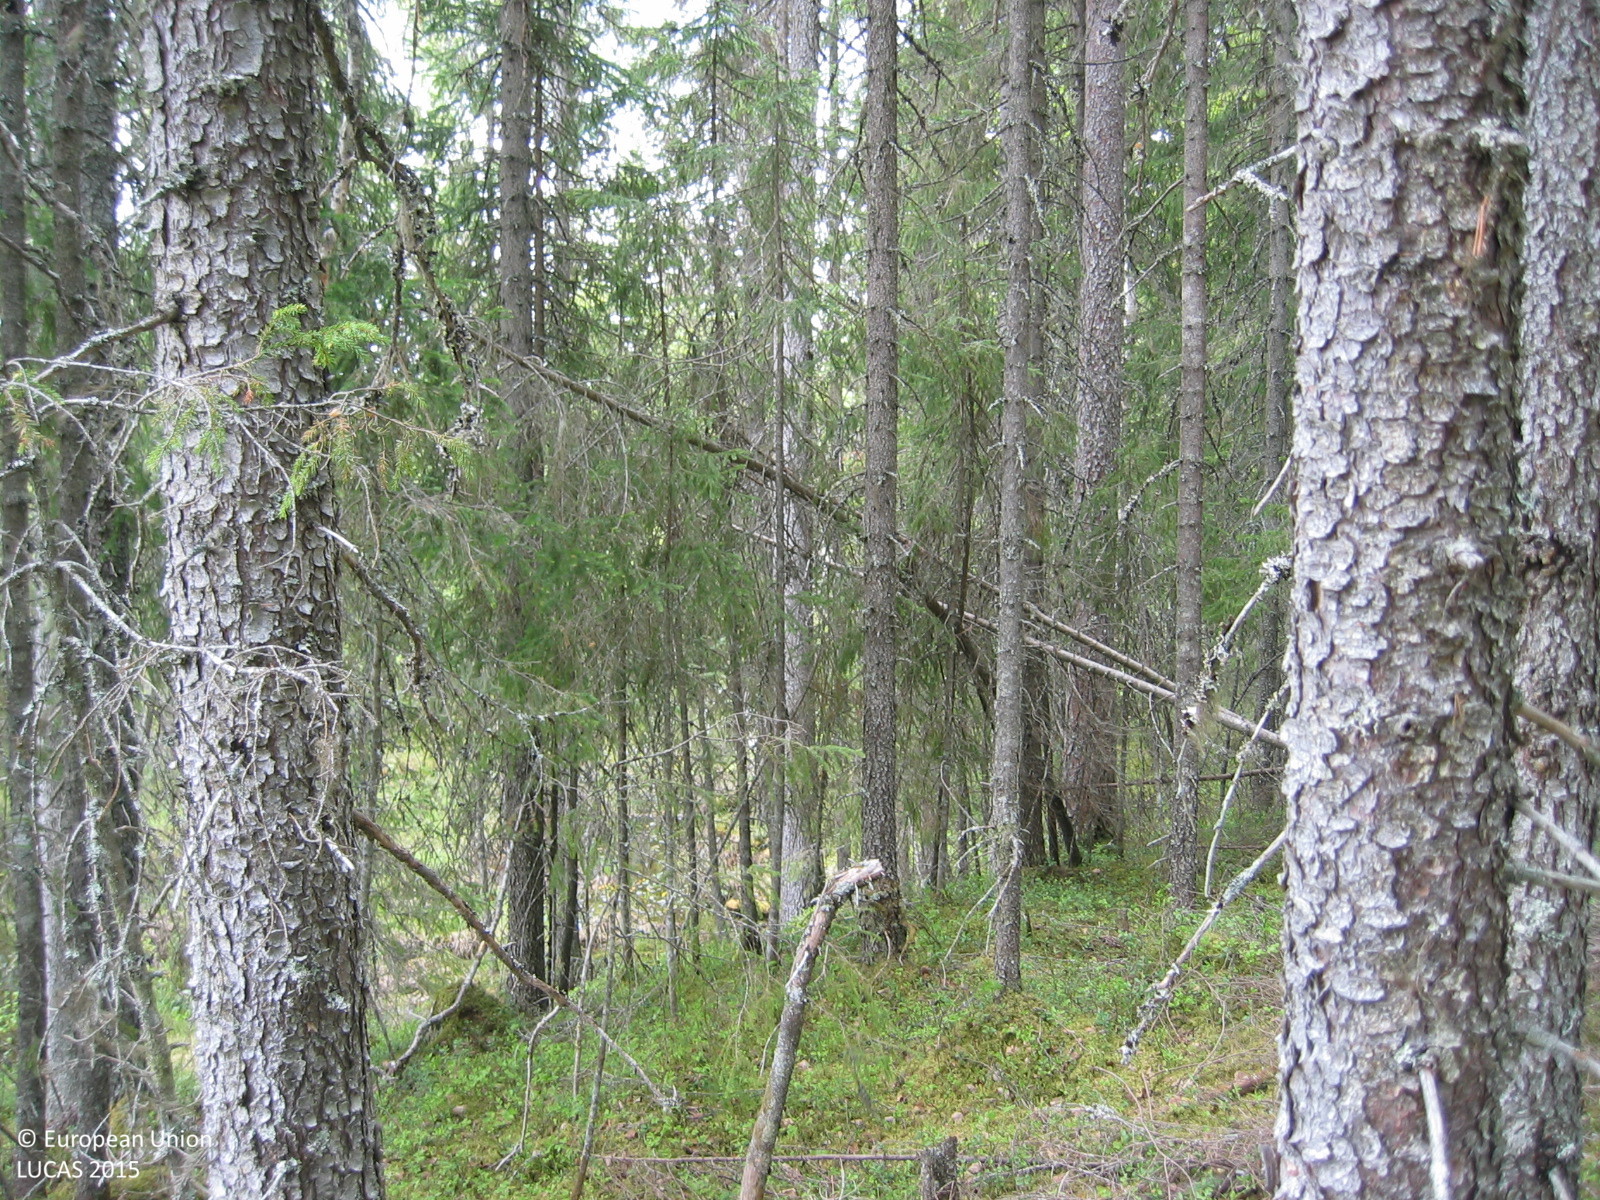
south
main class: Woodland
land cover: Spruce dominated coniferous woodland
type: boreal forest
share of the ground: > 75 %
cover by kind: coniferous forest trees 85 %, shrubs 10 %, broadleaved forest trees 5 %
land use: Forestry
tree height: > 5 m
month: June
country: SE
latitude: 63.5699
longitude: 14.6690
